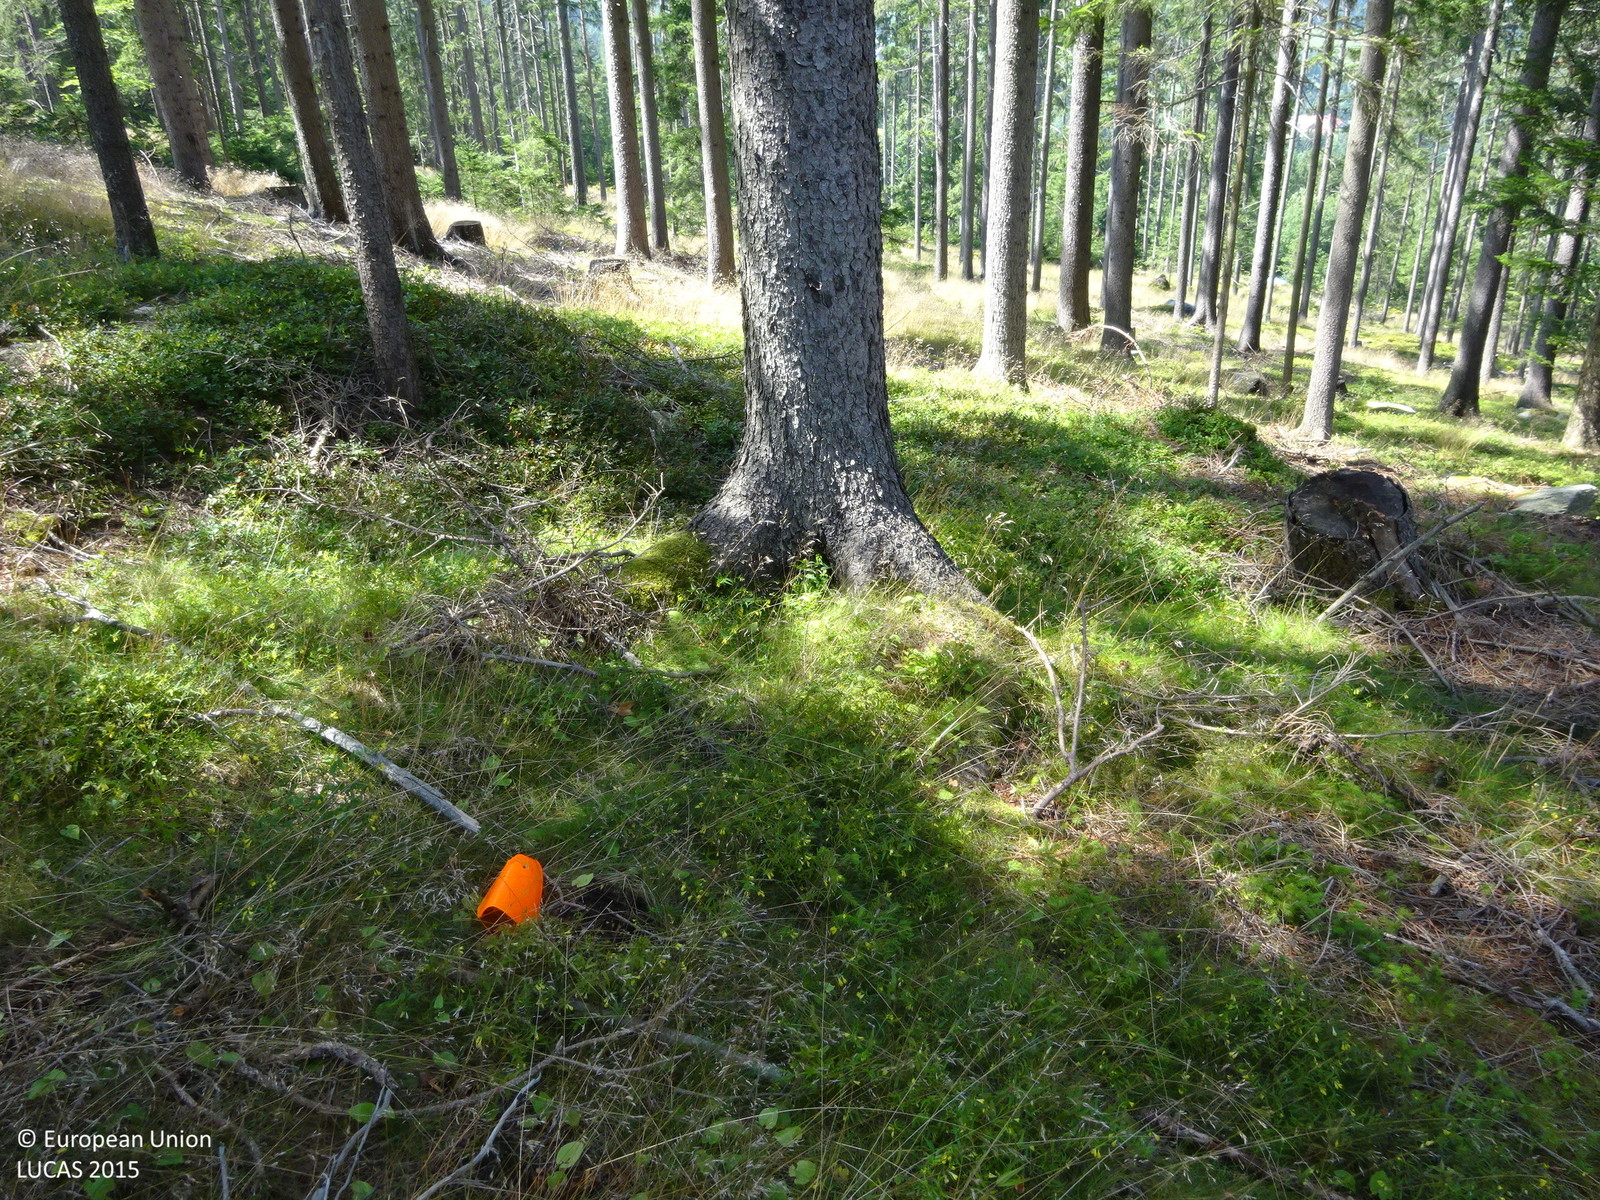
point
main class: Woodland
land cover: Spruce dominated coniferous woodland
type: alpine coniferous forest
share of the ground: > 75 %
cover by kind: coniferous forest trees 95 %, herbaceous plants 5 %
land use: Forestry
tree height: > 5 m
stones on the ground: < 10 %
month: August
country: AT
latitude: 47.3154
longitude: 15.7558
